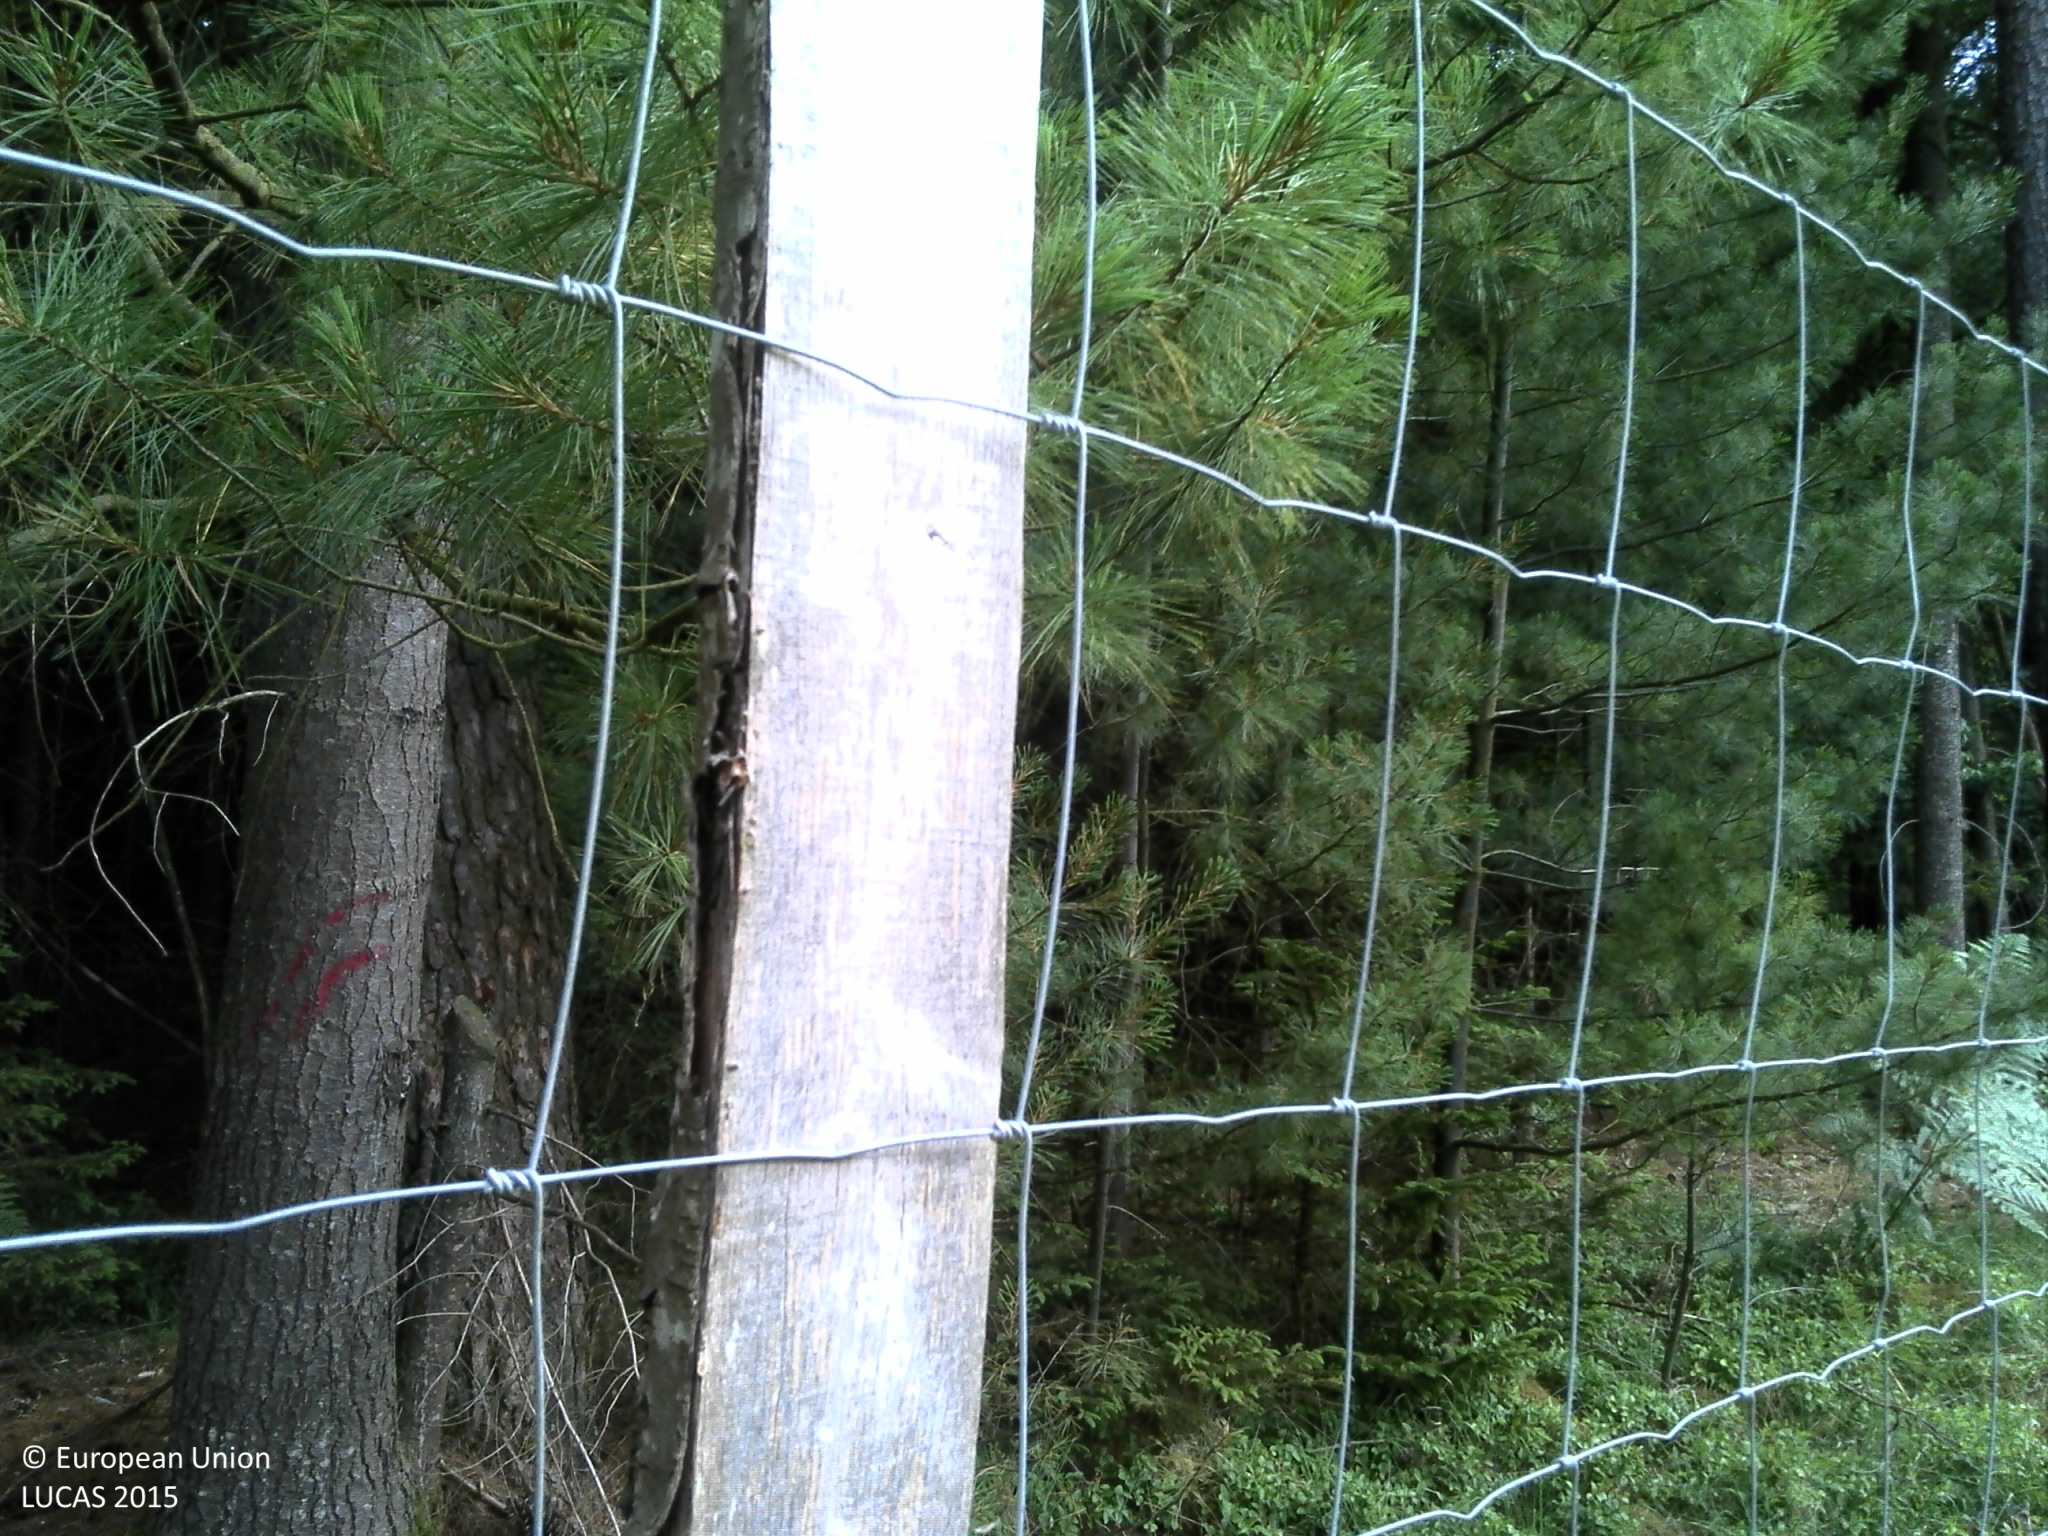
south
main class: Woodland
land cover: Spruce dominated coniferous woodland
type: hemiboreal forest and nemoral coniferous forest and mixed broadleaved-coniferous forest
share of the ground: > 75 %
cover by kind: coniferous forest trees 90 %, broadleaved forest trees 10 %
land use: Forestry
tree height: > 5 m
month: July
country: FR
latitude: 49.0052
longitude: 7.4989
